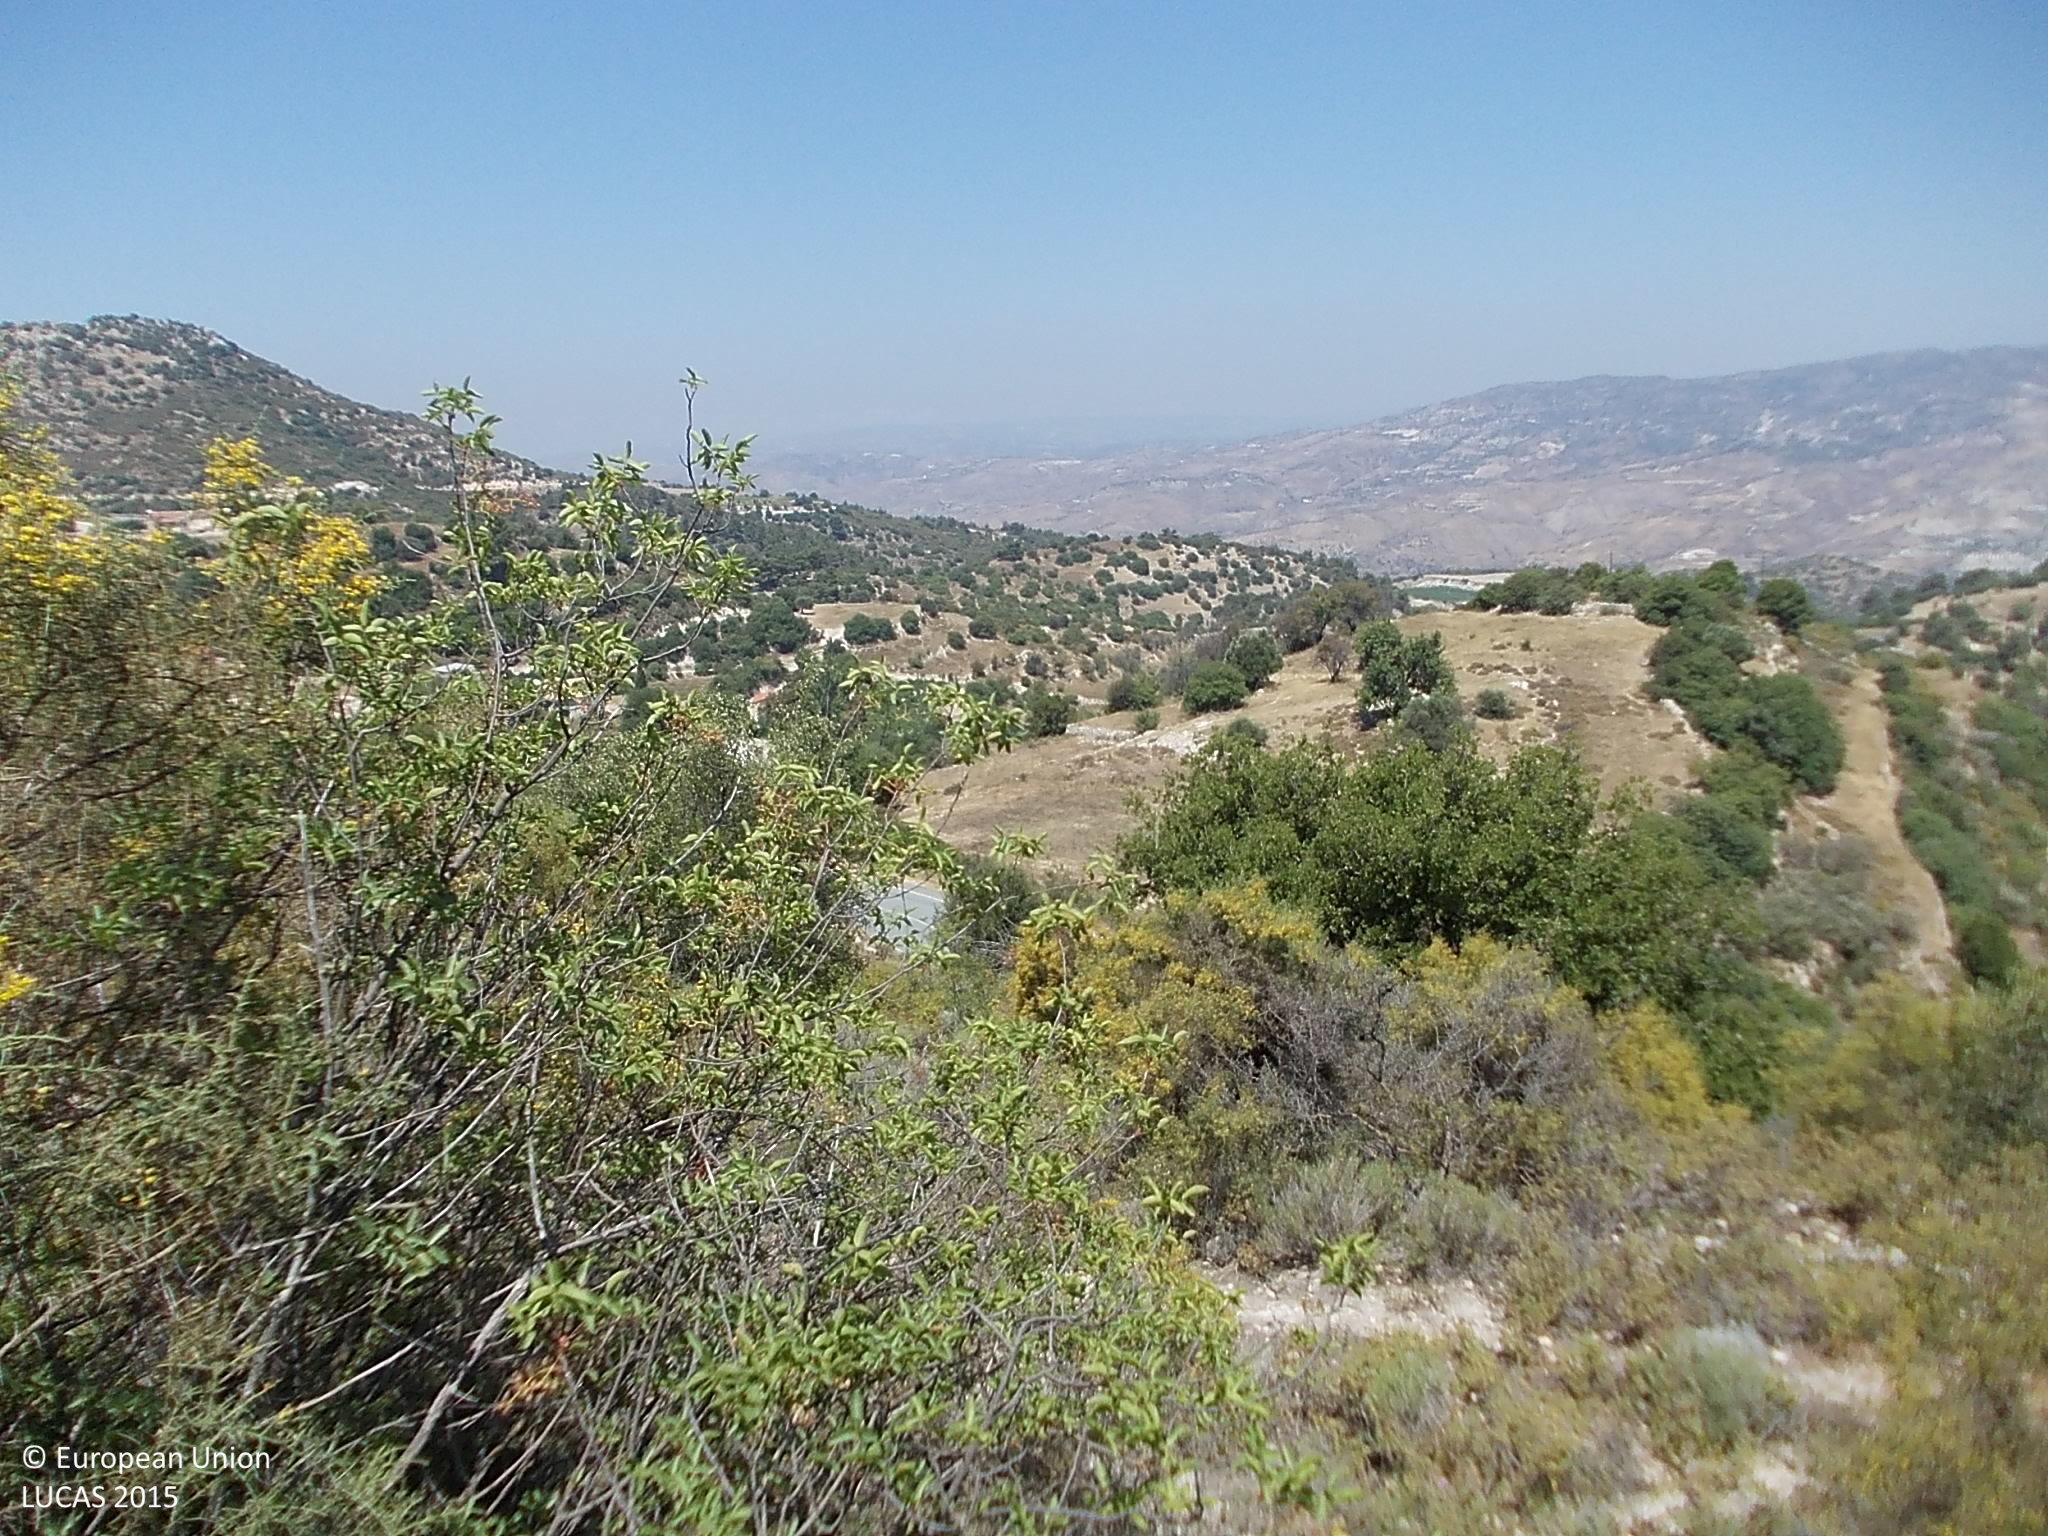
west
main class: Woodland
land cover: Broadleaved woodland
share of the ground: 10 - 25 %
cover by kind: shrubs 60 %, broadleaved forest trees 20 %, herbaceous plants 10 %, coniferous forest trees 5 %, unconsolidated bare surface 5 %
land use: Semi-natural and natural areas not in use
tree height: < 5 m
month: July
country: CY
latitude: 34.7717
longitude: 32.7187
